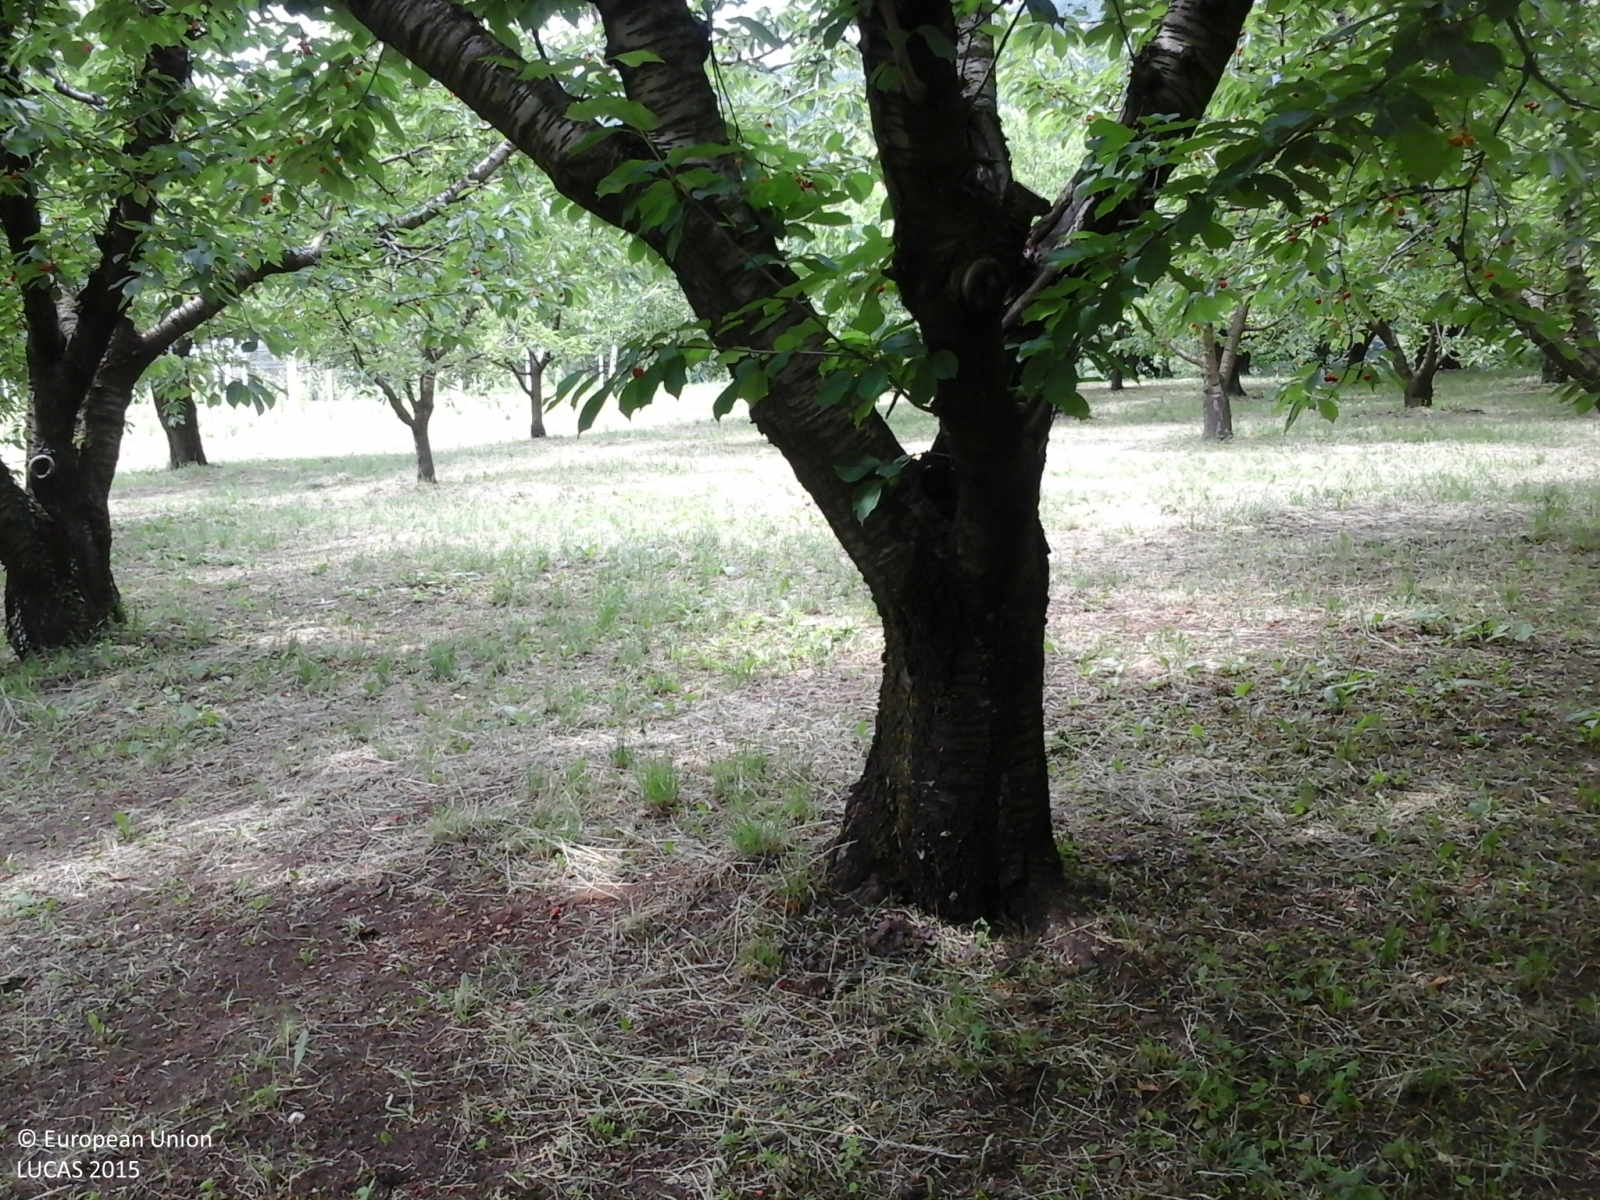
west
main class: Cropland
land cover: Cherry fruit
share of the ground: > 75 %
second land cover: Grassland without tree/shrub cover
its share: > 75 %
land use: Agriculture (excluding fallow land and kitchen gardens)
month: June
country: IT
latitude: 45.5724
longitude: 10.9339
